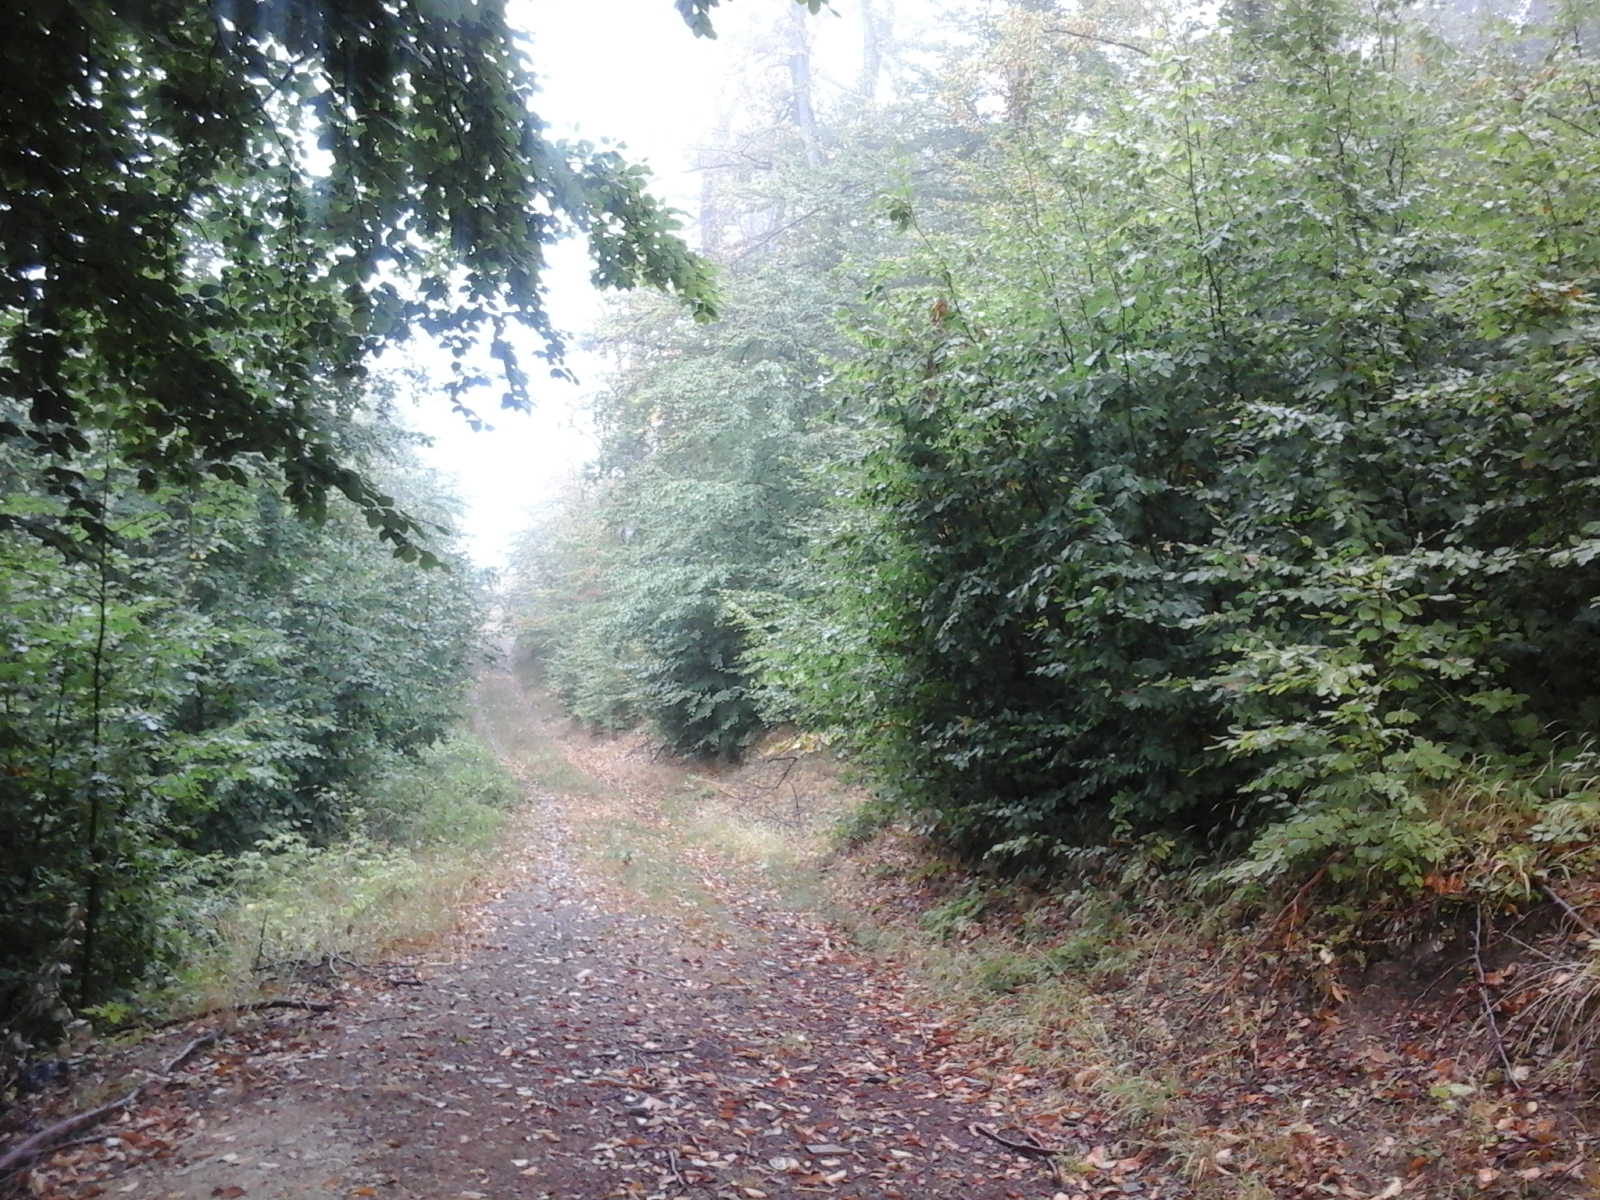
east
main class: Woodland
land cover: Broadleaved woodland
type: beech forest
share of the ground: > 75 %
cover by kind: broadleaved forest trees 100 %
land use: Forestry
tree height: > 5 m
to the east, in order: Broadleaved woodland
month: August
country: RO
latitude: 45.0404
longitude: 22.7276
